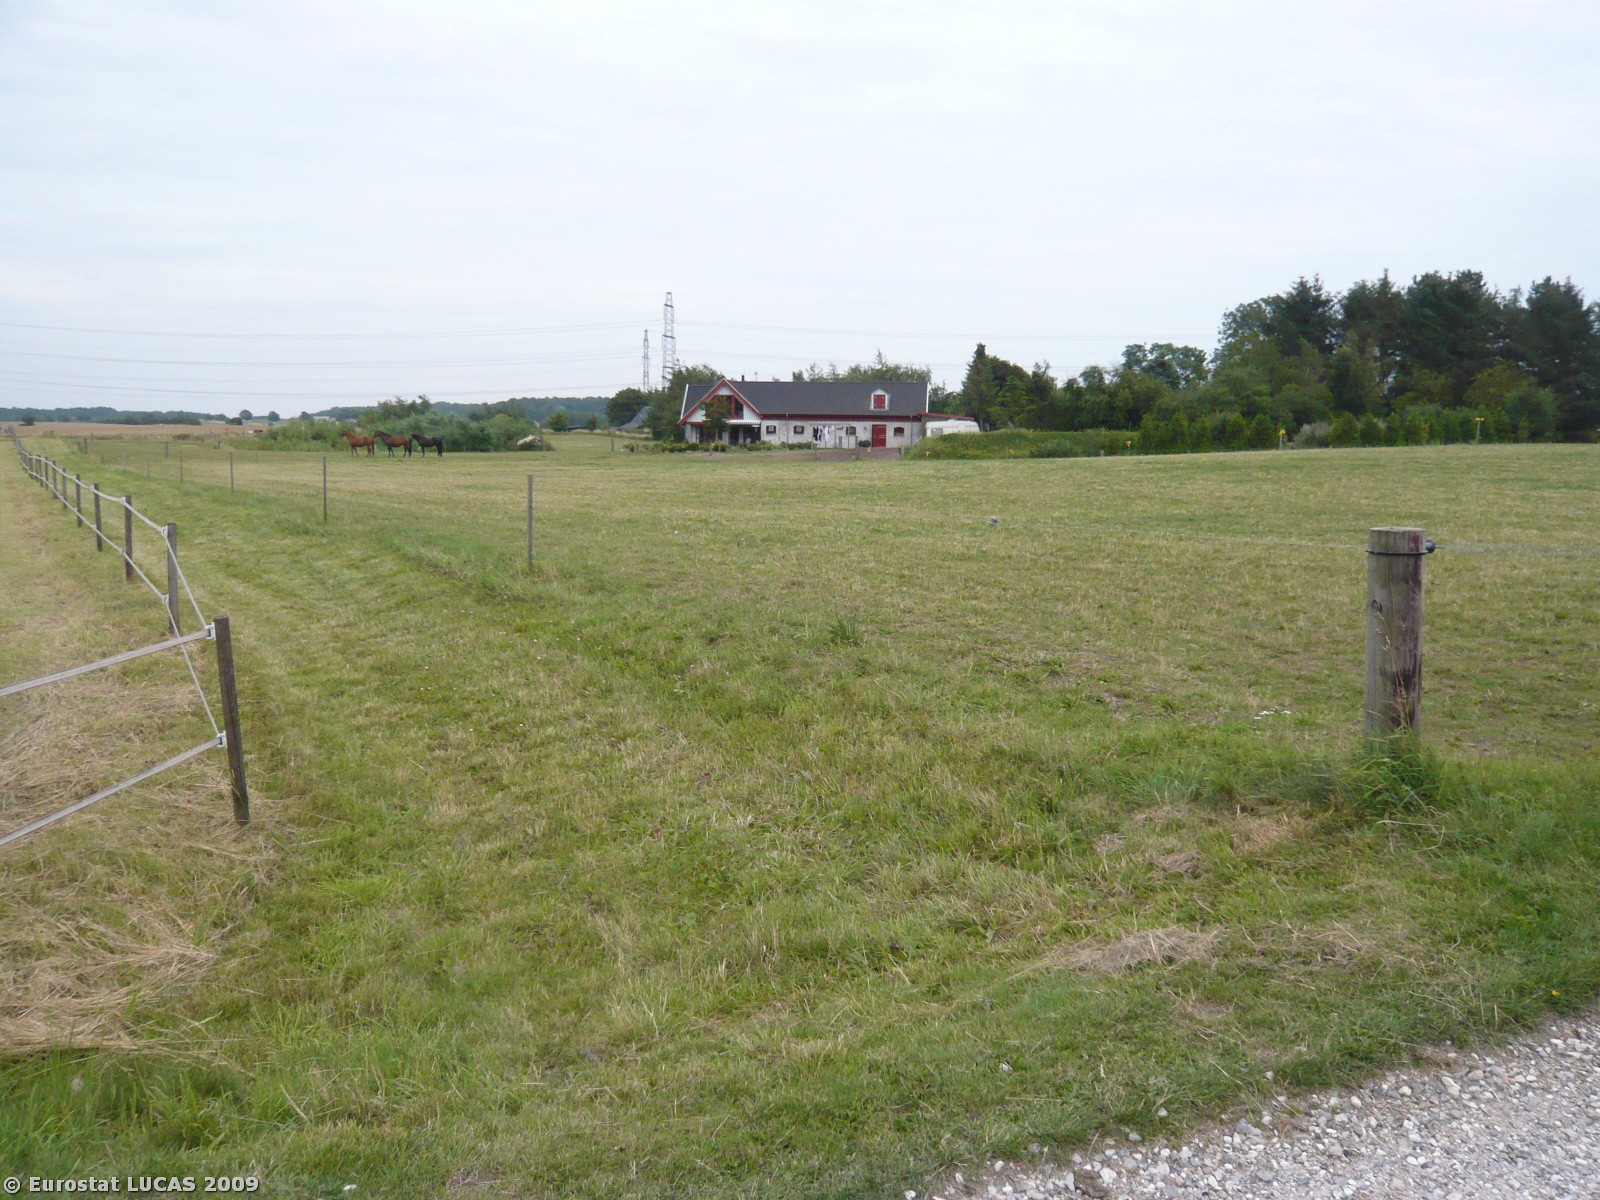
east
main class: Cropland
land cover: Oats
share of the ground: > 75 %
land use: Agriculture (excluding fallow land and kitchen gardens)
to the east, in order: Oats; Fences; Grassland without tree/shrub cover; Artificial constructions in urban areas; Grassland without tree/shrub cover; Fences; Grassland without tree/shrub cover; Fences; Oats; Grass margins; Tracks; Fences; Grassland without tree/shrub cover
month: July
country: DK
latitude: 55.8640
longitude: 12.1551
